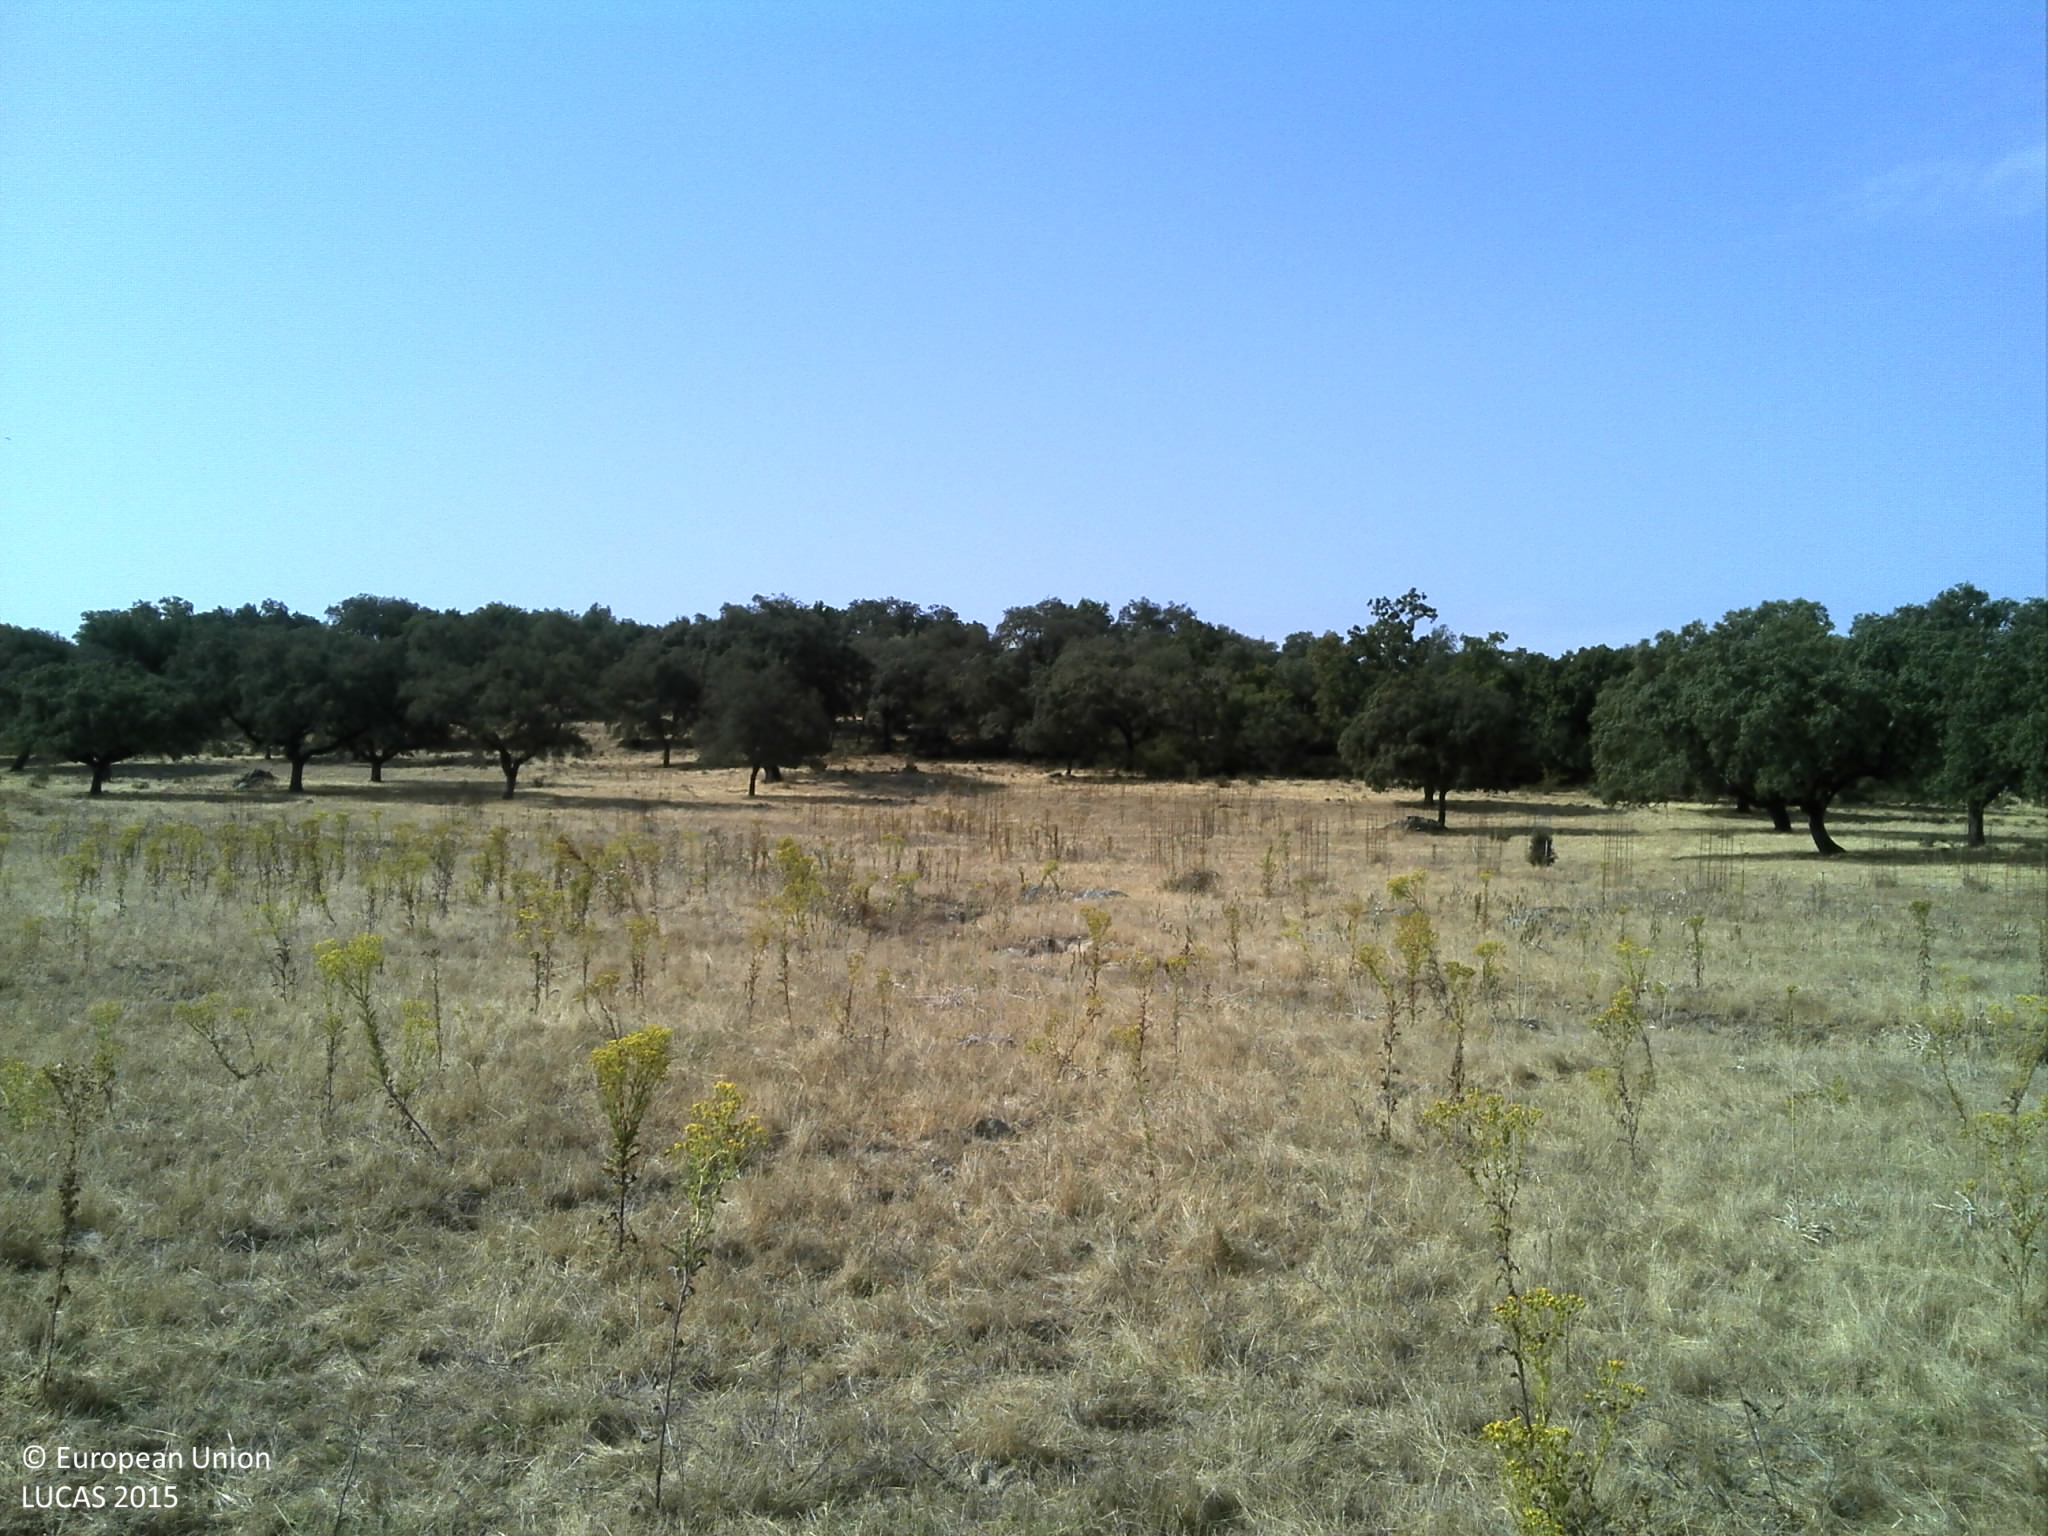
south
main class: Grassland
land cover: Grassland without tree/shrub cover
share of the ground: 50 - 75 %
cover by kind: herbaceous plants 60 %, unconsolidated bare surface 40 %
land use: Agriculture (excluding fallow land and kitchen gardens)
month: August
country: PT
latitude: 39.2964
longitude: -7.5651
